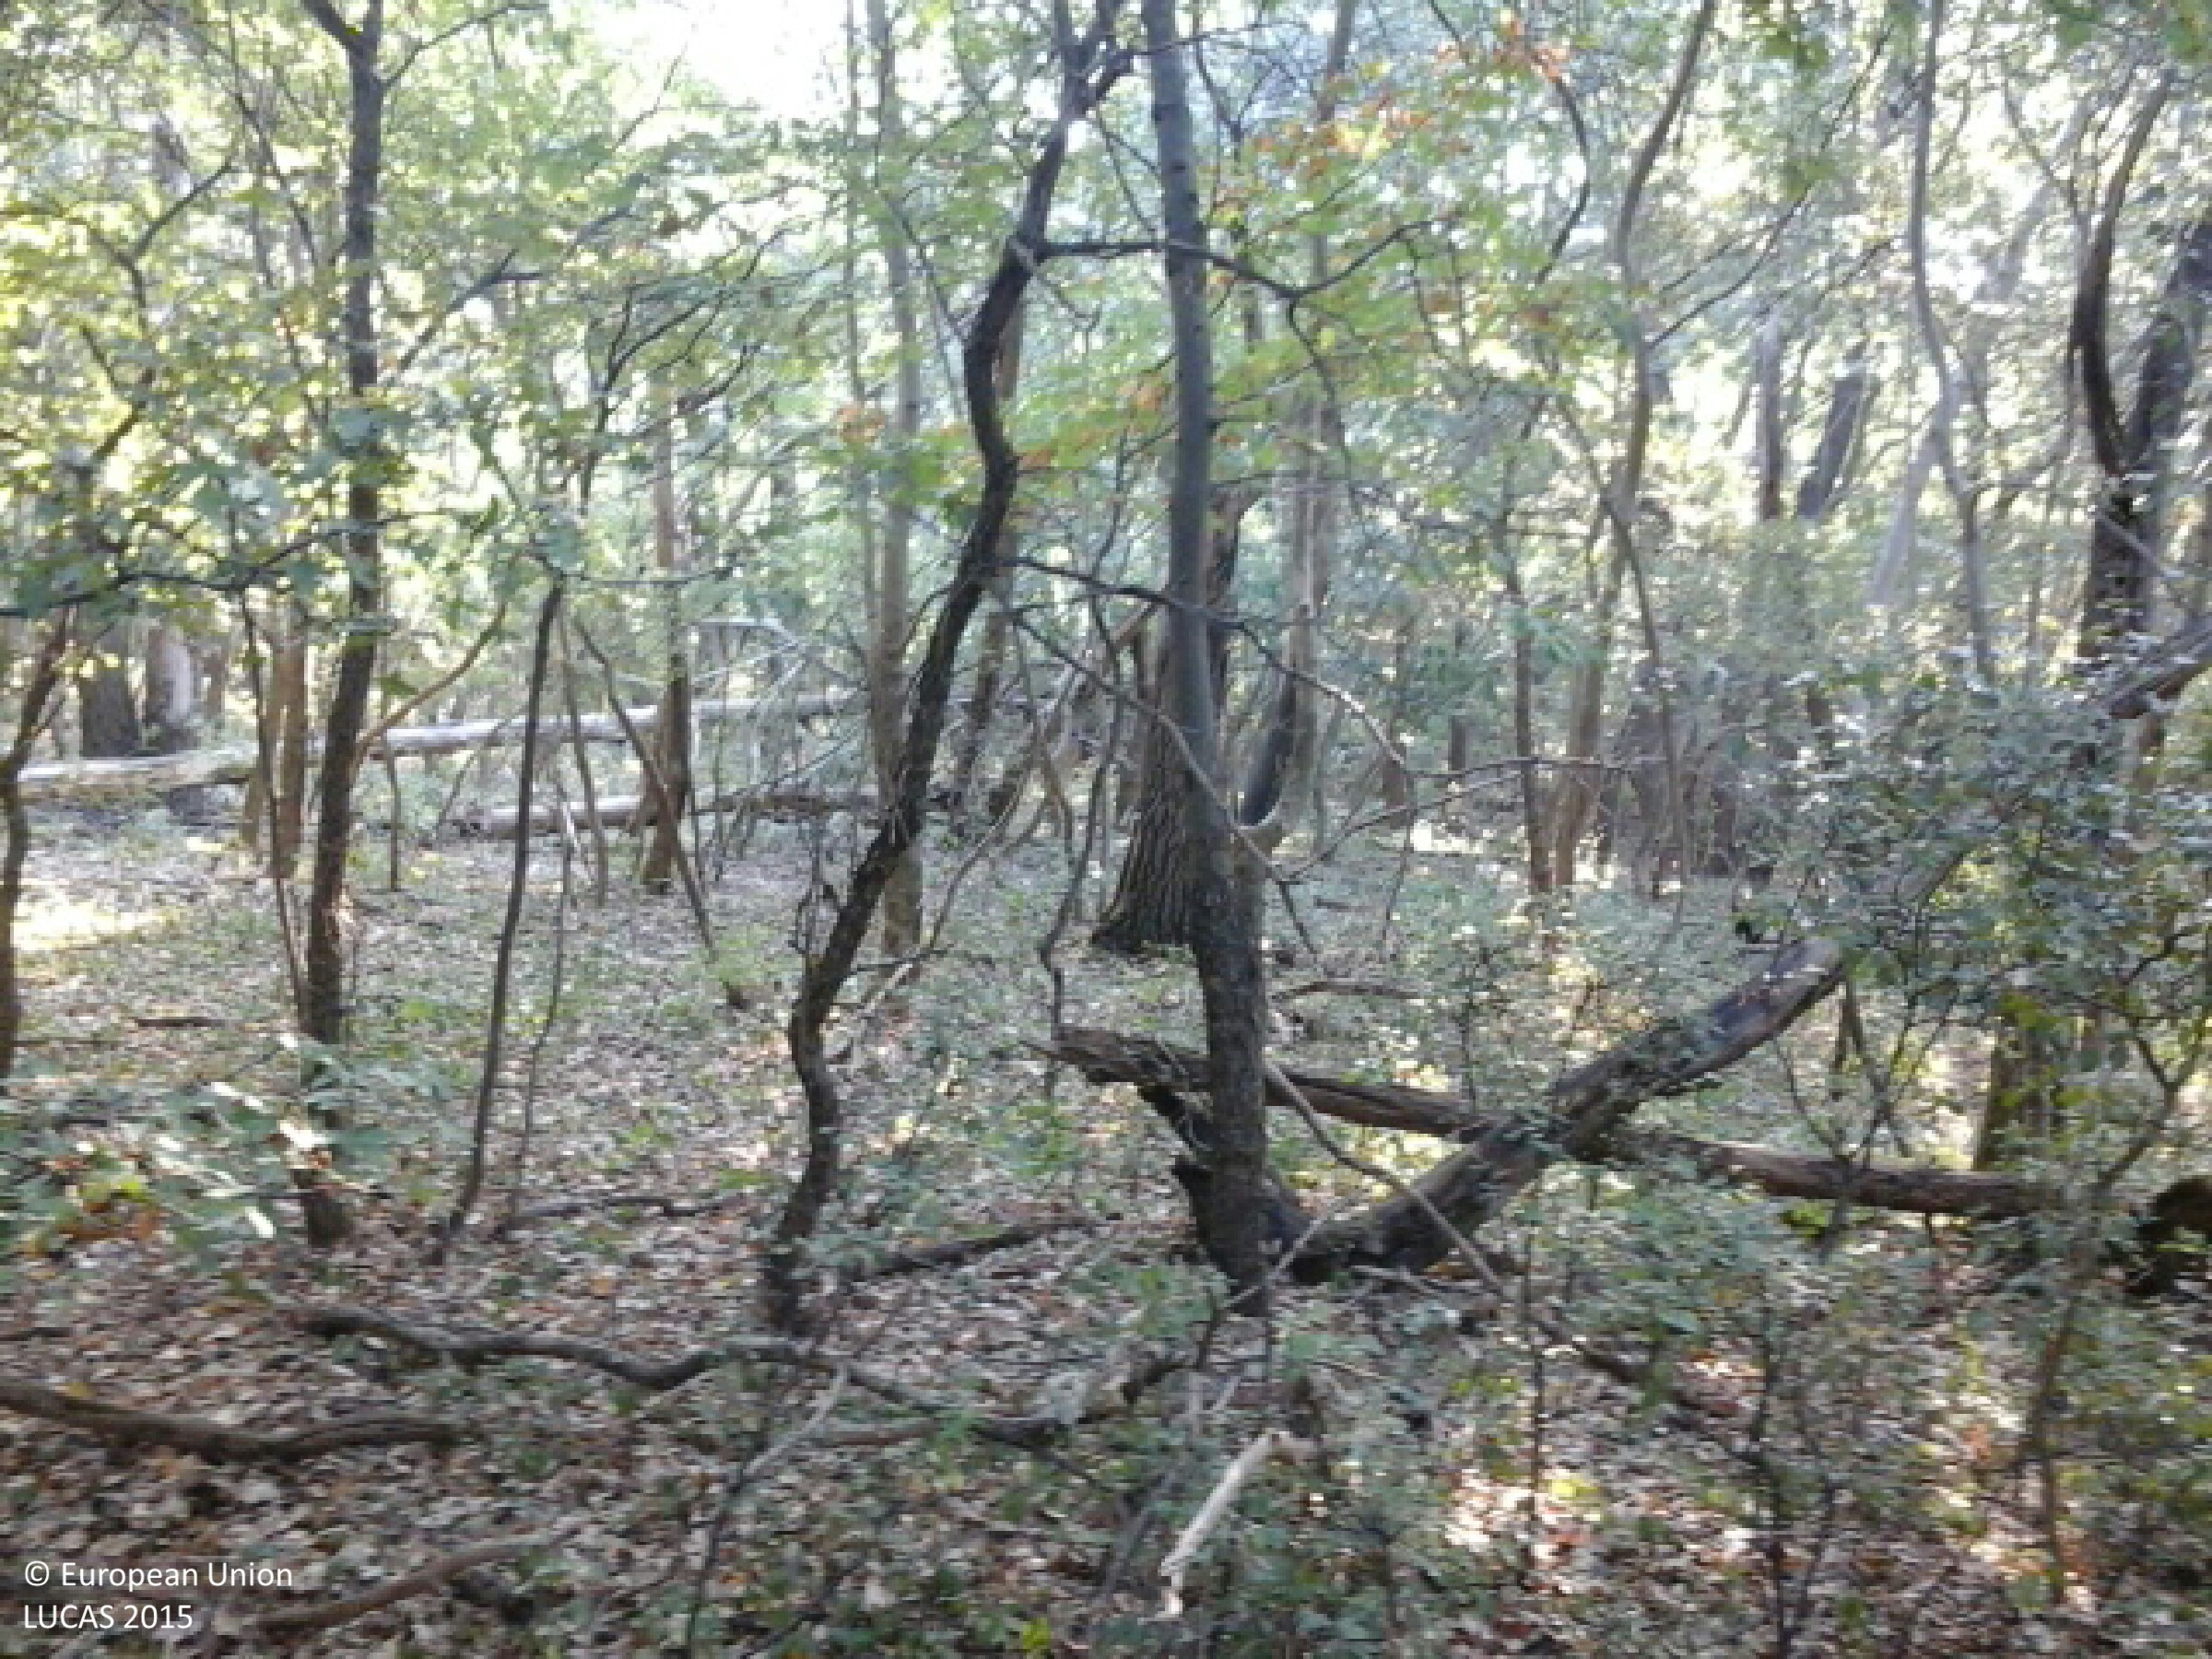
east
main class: Woodland
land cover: Broadleaved woodland
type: mesophytic deciduous forest
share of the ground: > 75 %
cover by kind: broadleaved forest trees 95 %, shrubs 5 %
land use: Forestry
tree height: > 5 m
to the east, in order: Broadleaved woodland; Tracks; Broadleaved woodland; Tracks; Broadleaved woodland
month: August
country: HU
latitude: 47.4950
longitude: 18.5226
